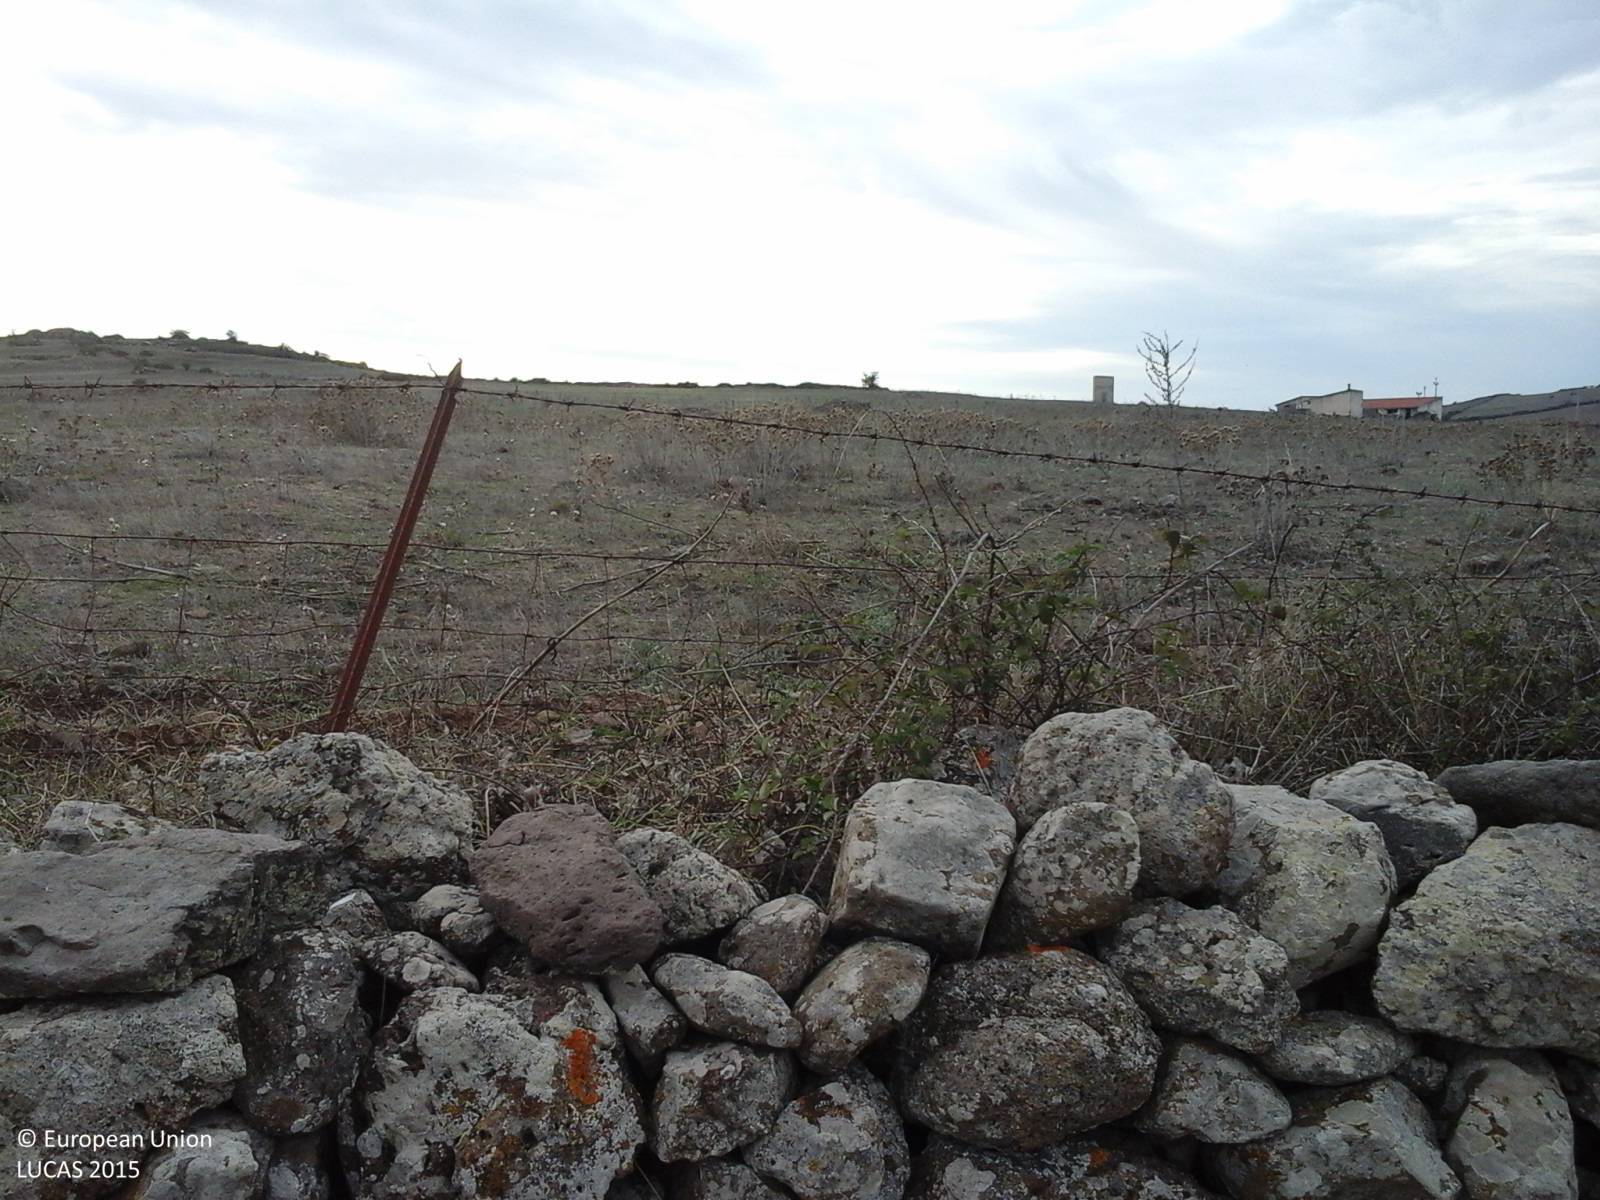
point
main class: Grassland
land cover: Grassland without tree/shrub cover
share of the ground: > 75 %
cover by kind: herbaceous plants 100 %
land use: Agriculture (excluding fallow land and kitchen gardens)
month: October
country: IT
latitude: 40.4032
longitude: 8.6753
